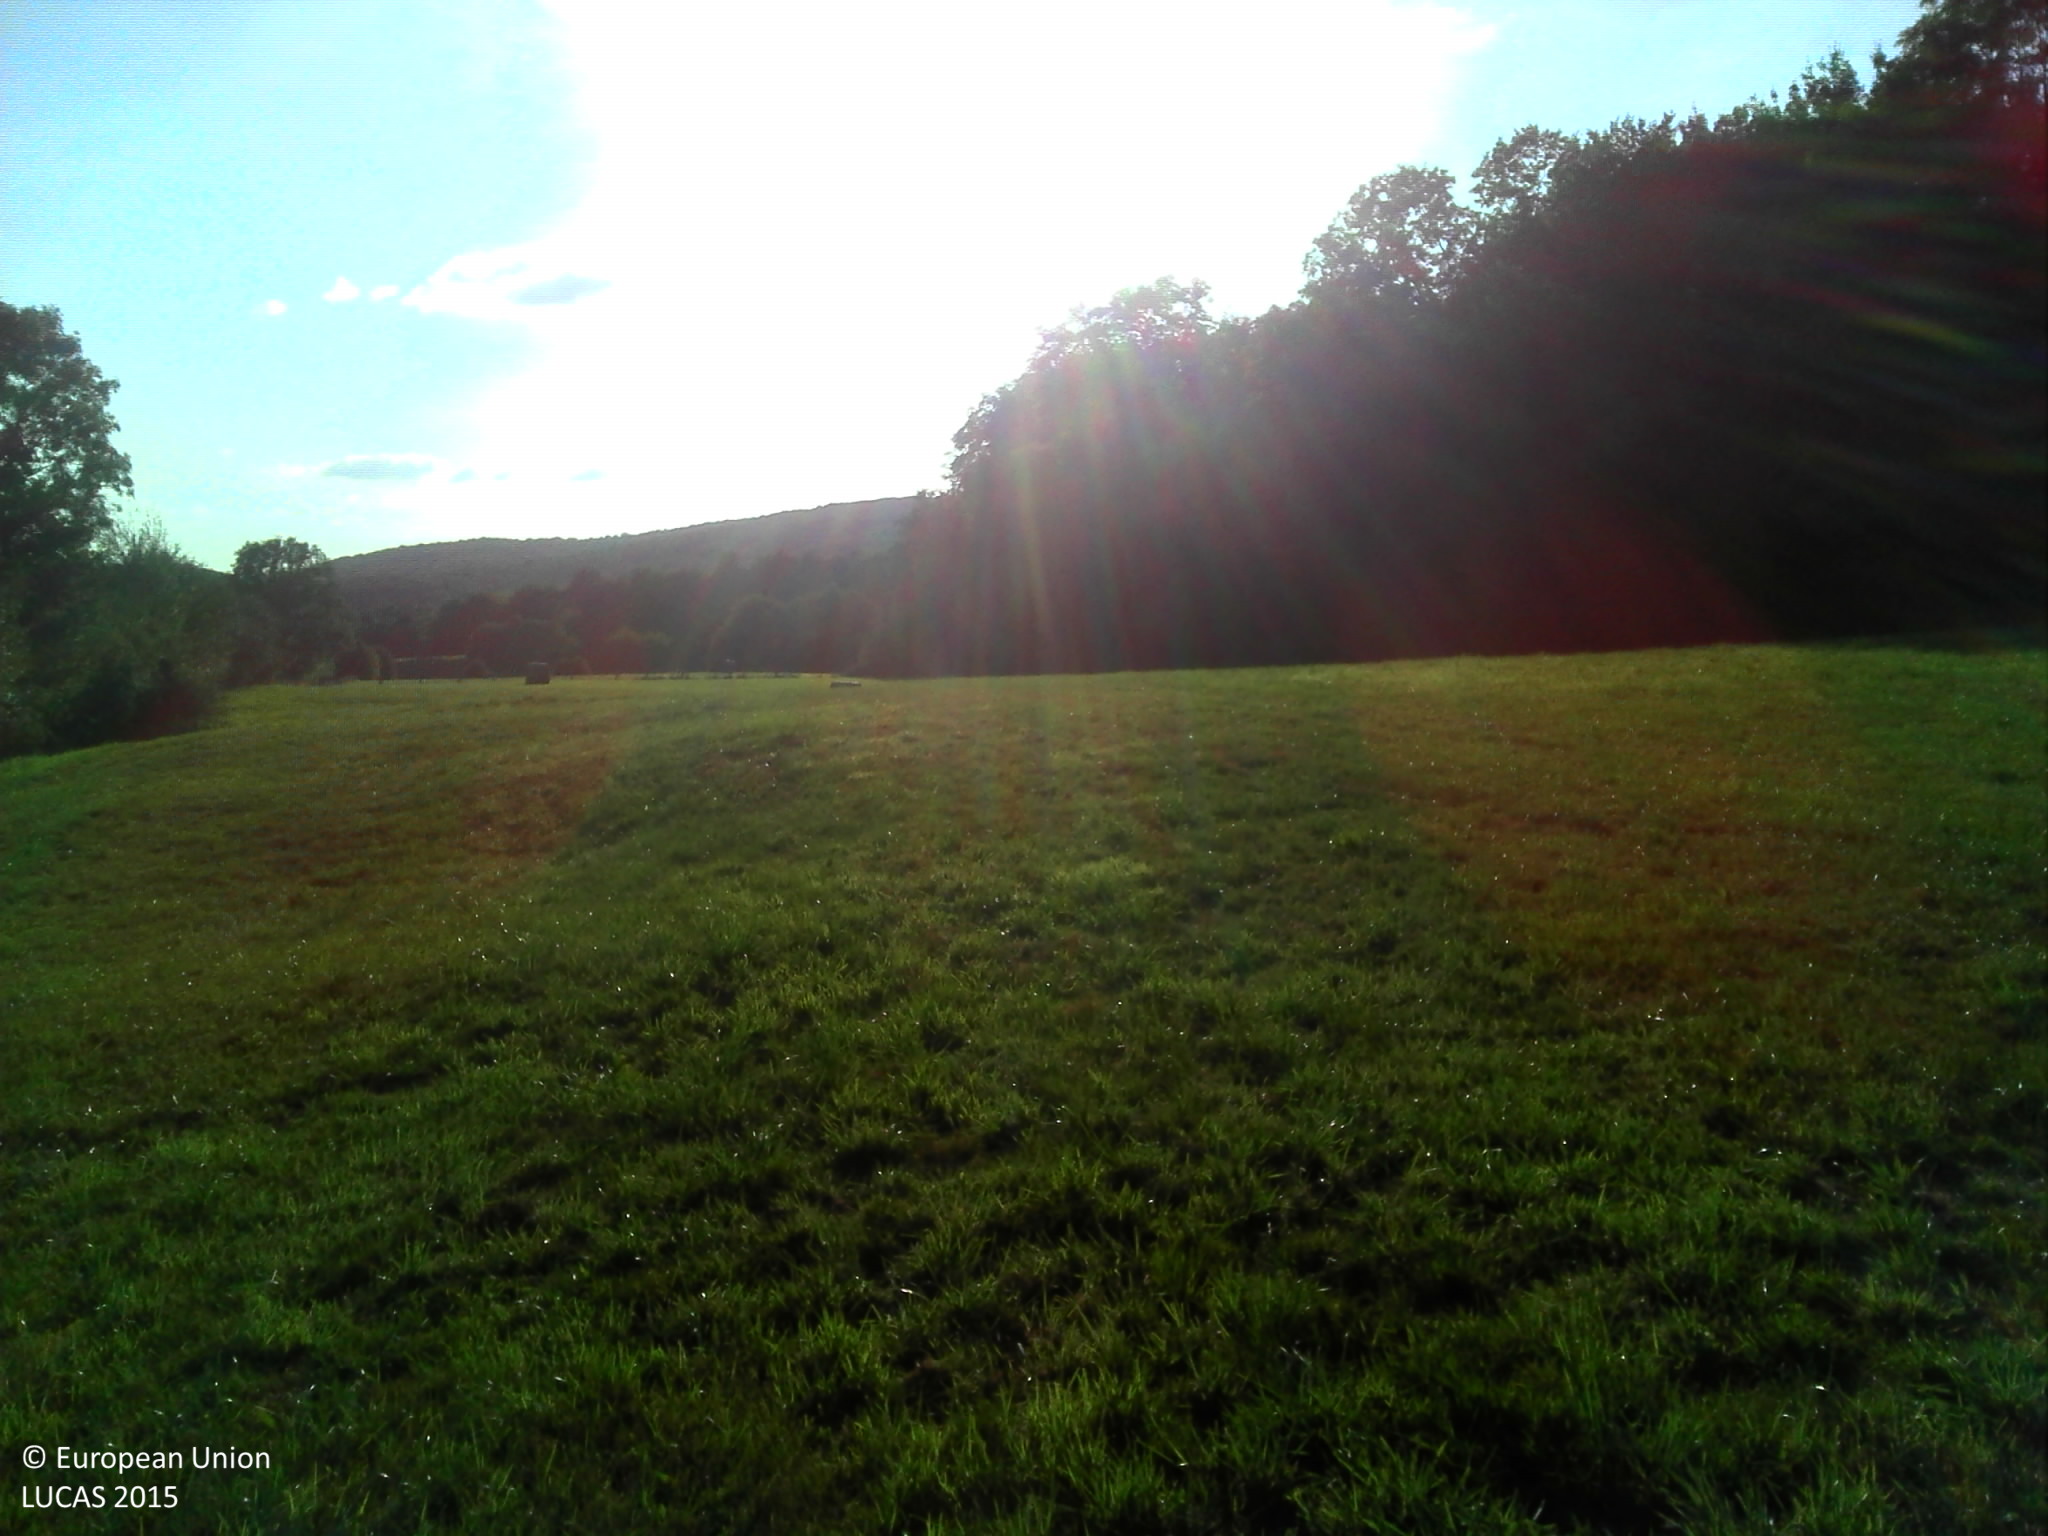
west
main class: Grassland
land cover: Grassland without tree/shrub cover
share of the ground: > 75 %
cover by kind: herbaceous plants 100 %
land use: Agriculture (excluding fallow land and kitchen gardens)
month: September
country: FR
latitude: 47.2953
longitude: 6.2594
